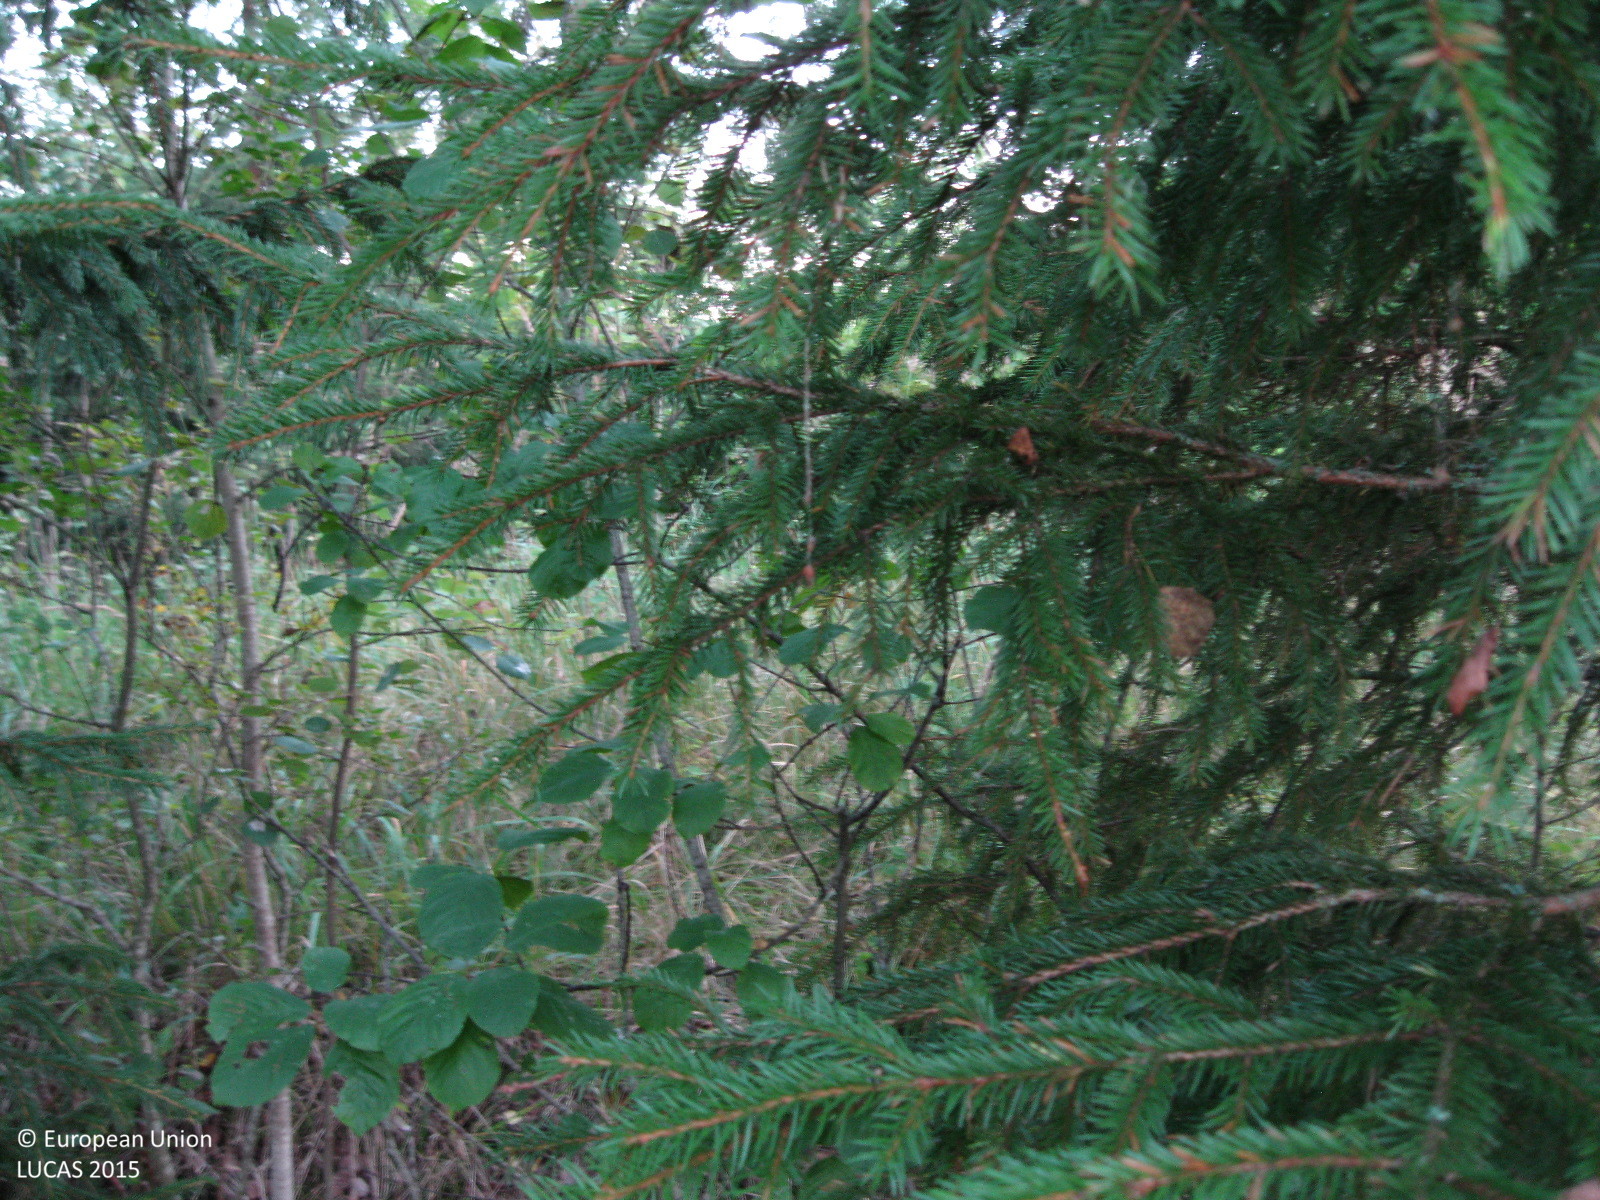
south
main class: Woodland
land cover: Spruce dominated mixed woodland
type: boreal forest
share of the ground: 50 - 75 %
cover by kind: coniferous forest trees 35 %, broadleaved forest trees 35 %, shrubs 25 %, herbaceous plants 5 %
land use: Forestry
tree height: < 5 m
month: September
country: FI
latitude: 60.6119
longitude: 24.7438
